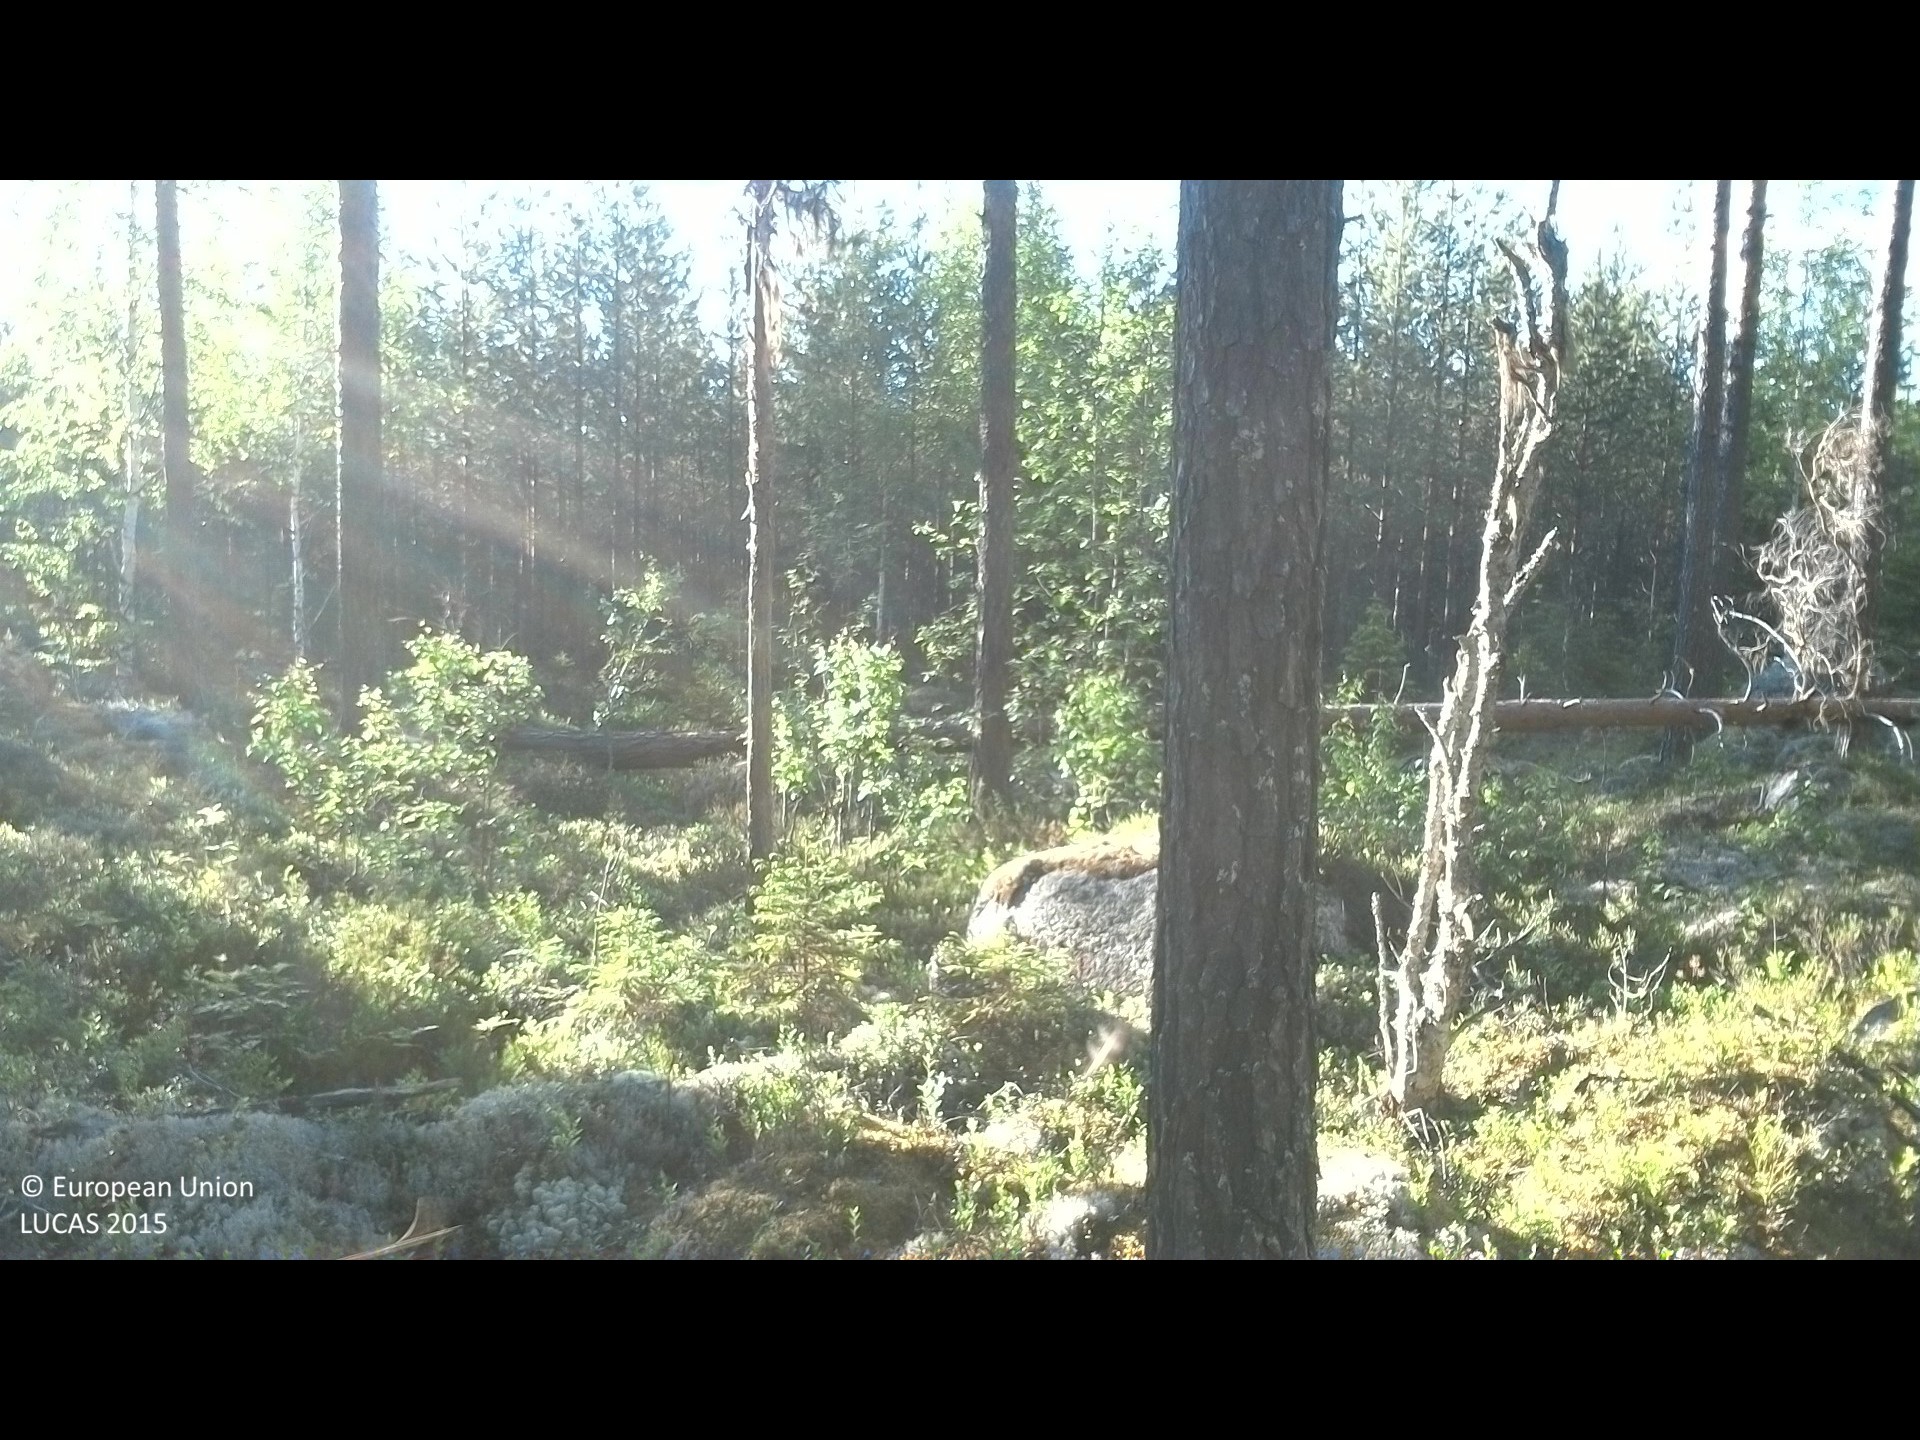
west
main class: Woodland
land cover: Pine dominated coniferous woodland
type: boreal forest
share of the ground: 25 - 50 %
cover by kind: coniferous forest trees 40 %, shrubs 30 %, lichens and mosses 25 %, broadleaved forest trees 5 %
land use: Forestry
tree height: > 5 m
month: June
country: SE
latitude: 62.0405
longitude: 16.0040
